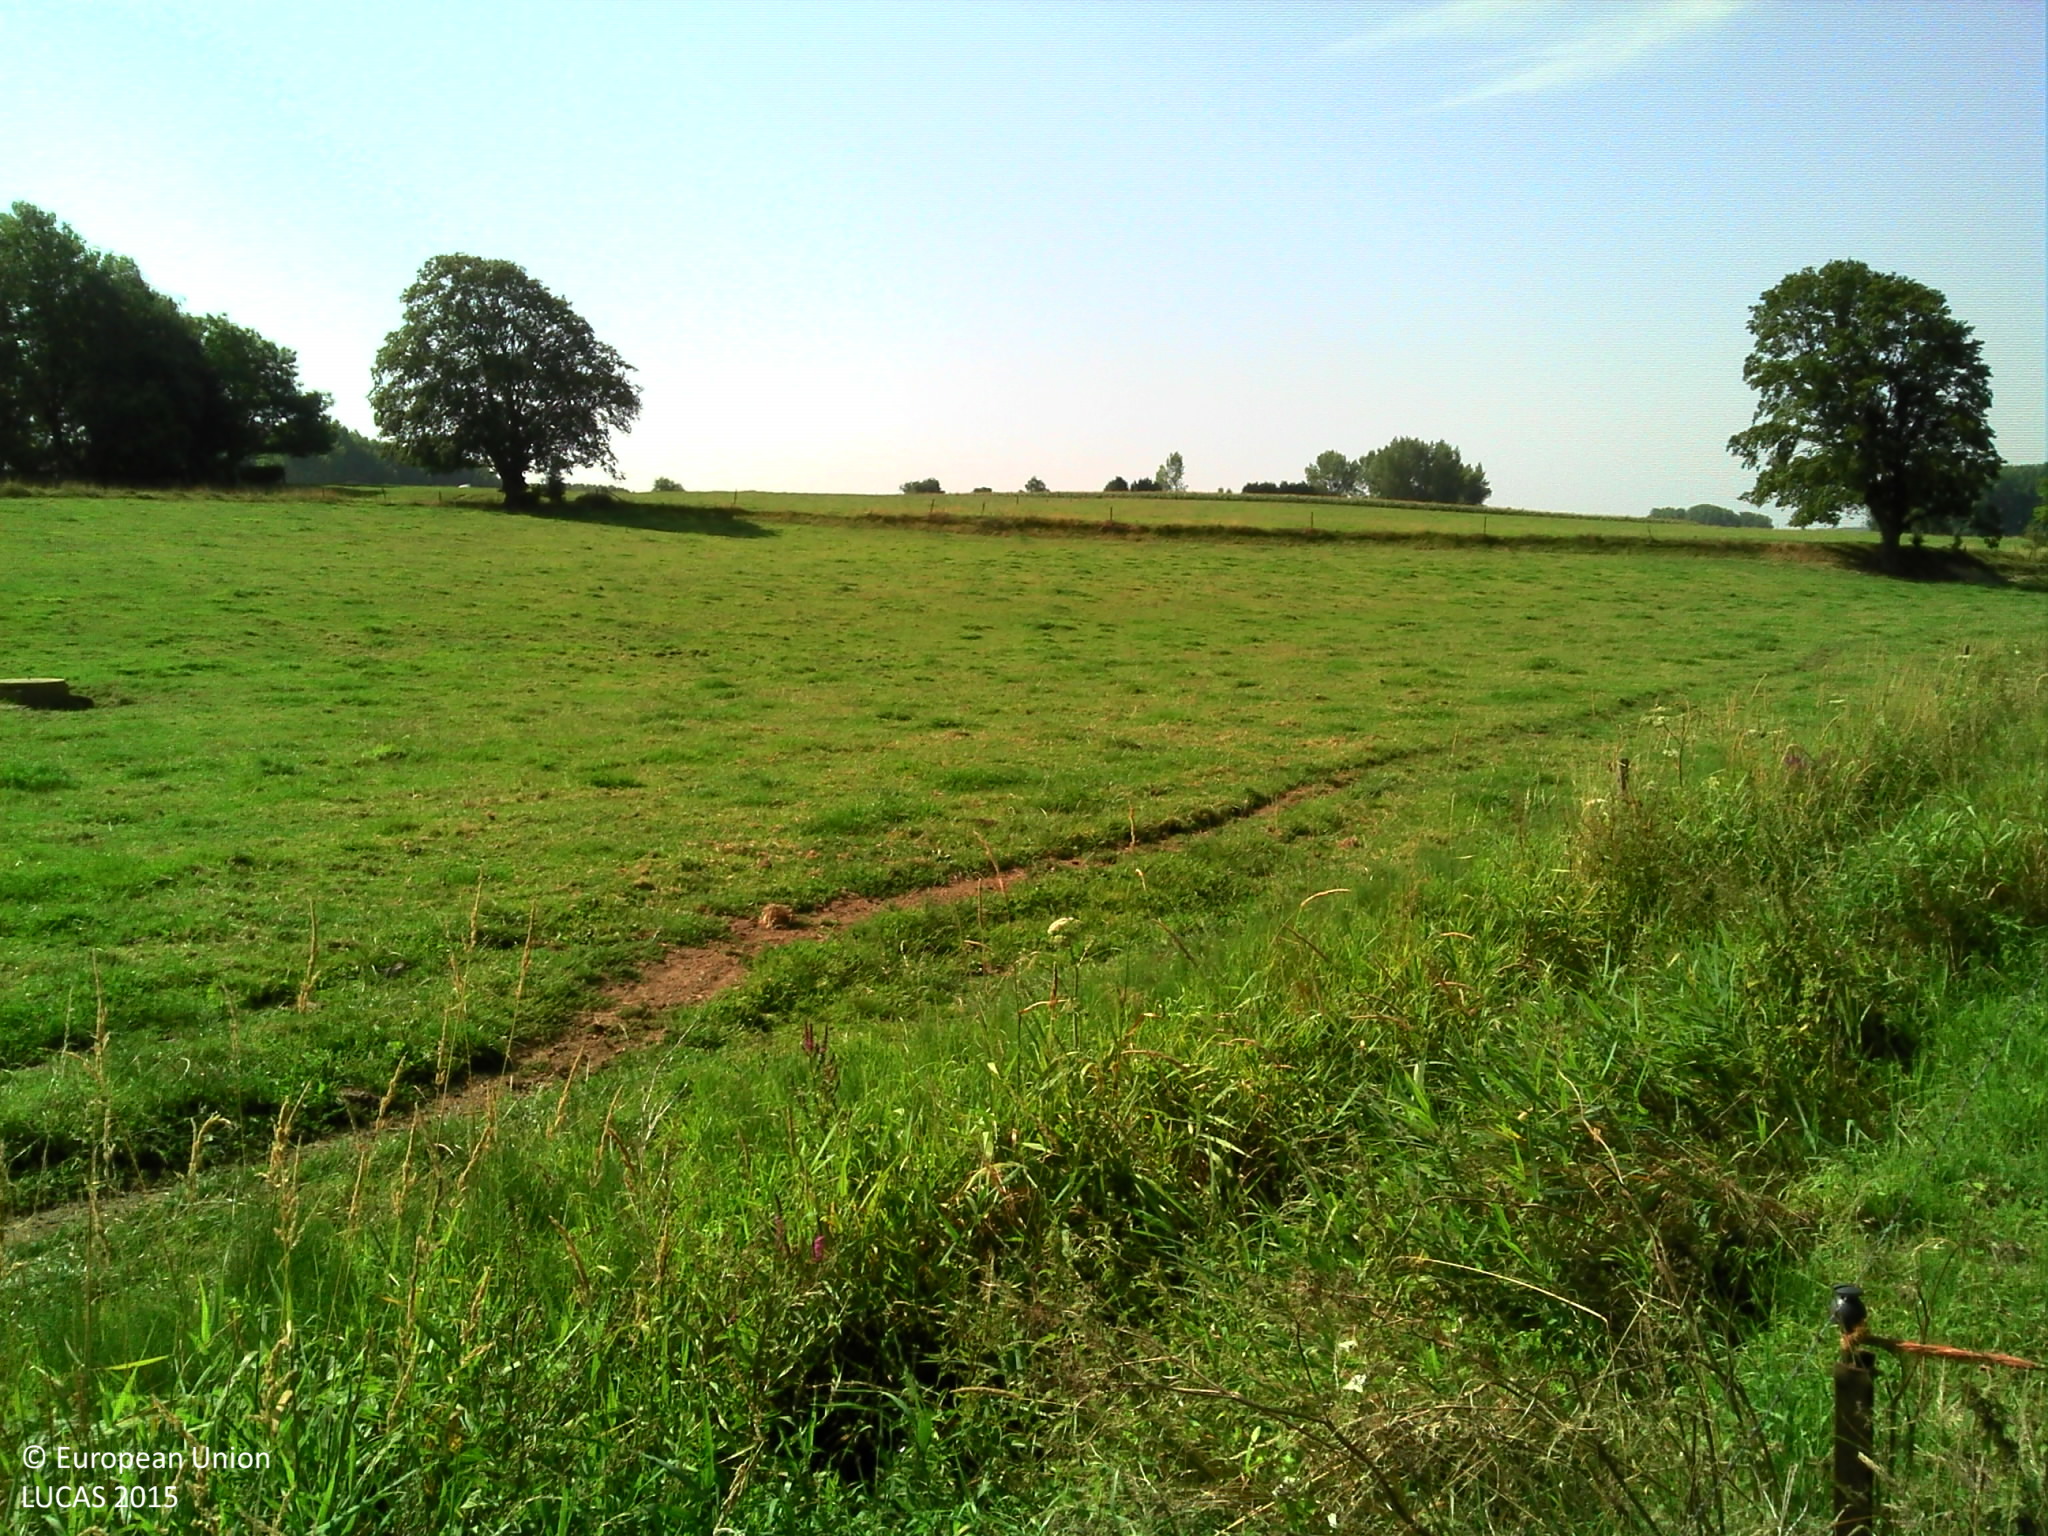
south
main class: Grassland
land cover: Spontaneously vegetated surfaces
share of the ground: > 75 %
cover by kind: herbaceous plants 100 %
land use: Agriculture (excluding fallow land and kitchen gardens)
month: August
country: BE
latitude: 50.6758
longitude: 4.0083
